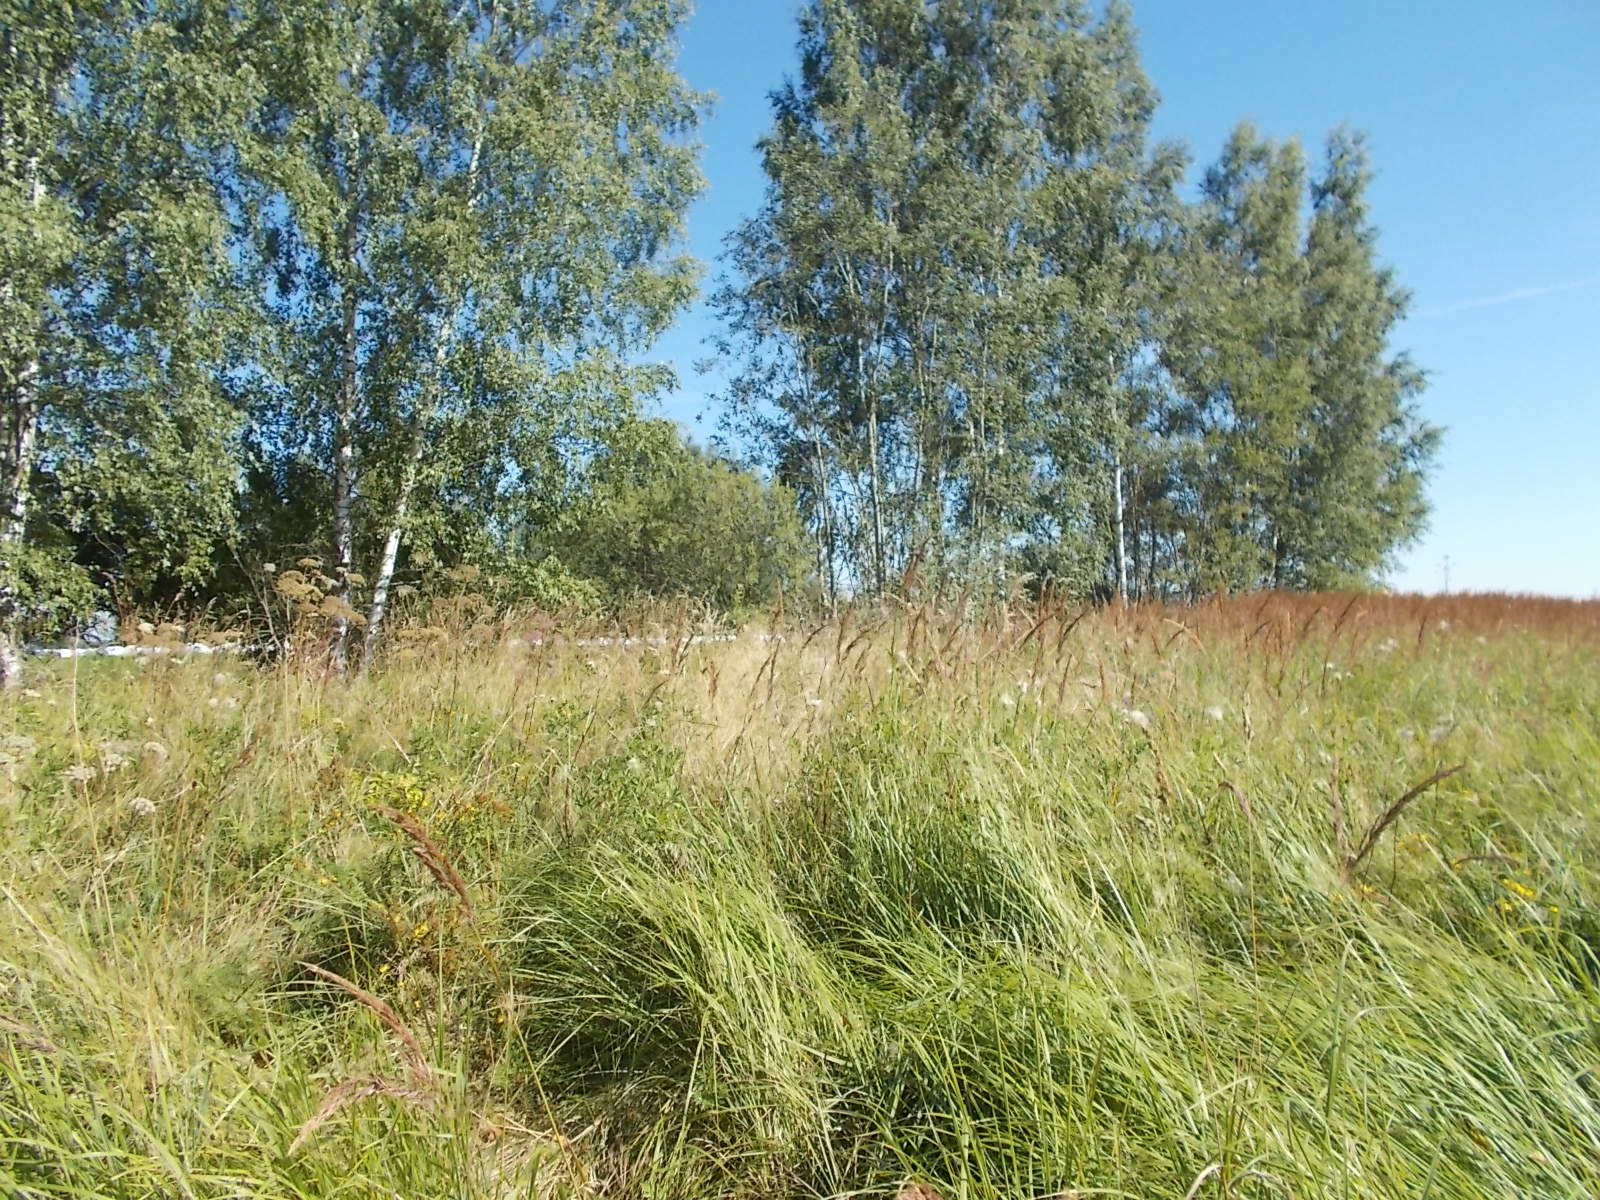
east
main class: Grassland
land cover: Spontaneously vegetated surfaces
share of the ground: > 75 %
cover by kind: herbaceous plants 95 %, shrubs 5 %
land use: Semi-natural and natural areas not in use
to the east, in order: Spontaneously vegetated surfaces; Abandoned hedges; Spontaneously vegetated surfaces; Broadleaved woodland; Grassland without tree/shrub cover; Broadleaved woodland; Grassland without tree/shrub cover; Tracks; Grassland without tree/shrub cover
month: August
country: LV
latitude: 56.8815
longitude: 22.9121
